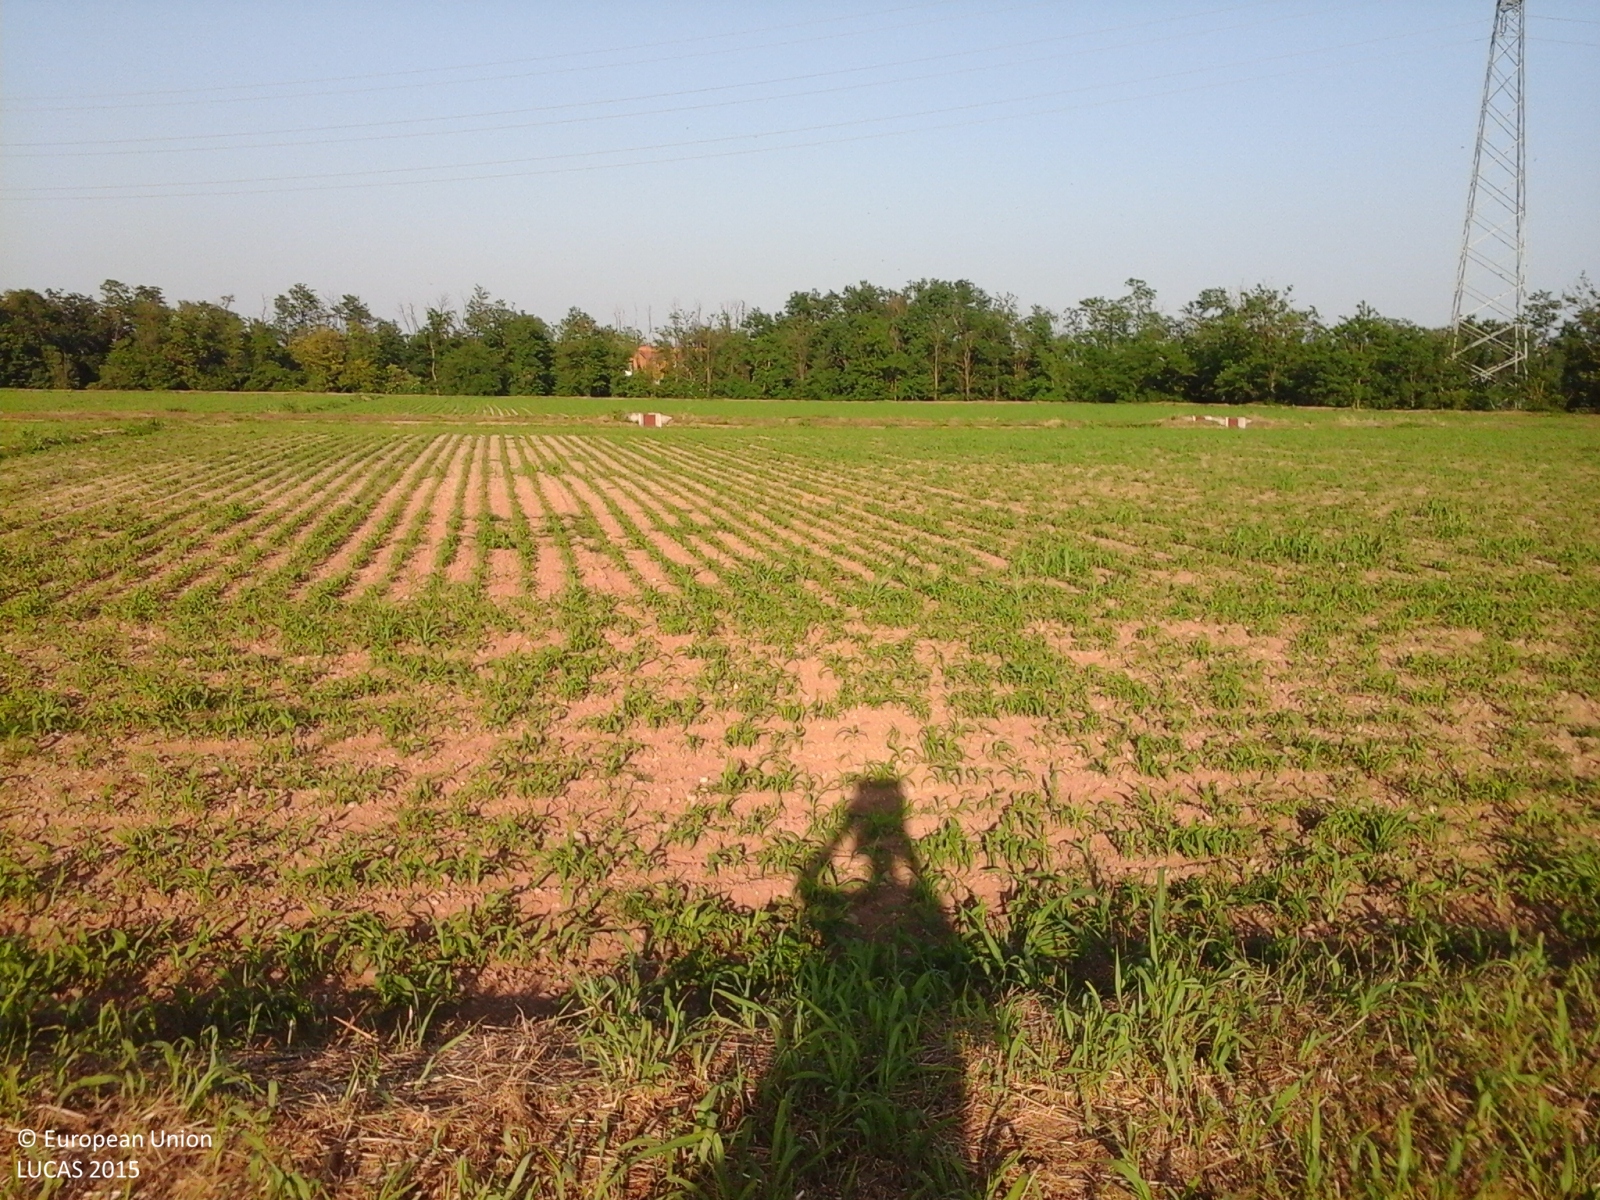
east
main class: Cropland
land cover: Common wheat
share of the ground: > 75 %
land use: Agriculture (excluding fallow land and kitchen gardens)
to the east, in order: Common wheat; Grass margins; Ditches and canals; Grass margins; Maize; Grass margins; Ditches and canals; Grass margins; Maize; Grass margins; Tracks; Electric lines; Grass margins; Maize
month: May
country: IT
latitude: 45.3727
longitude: 8.9165
